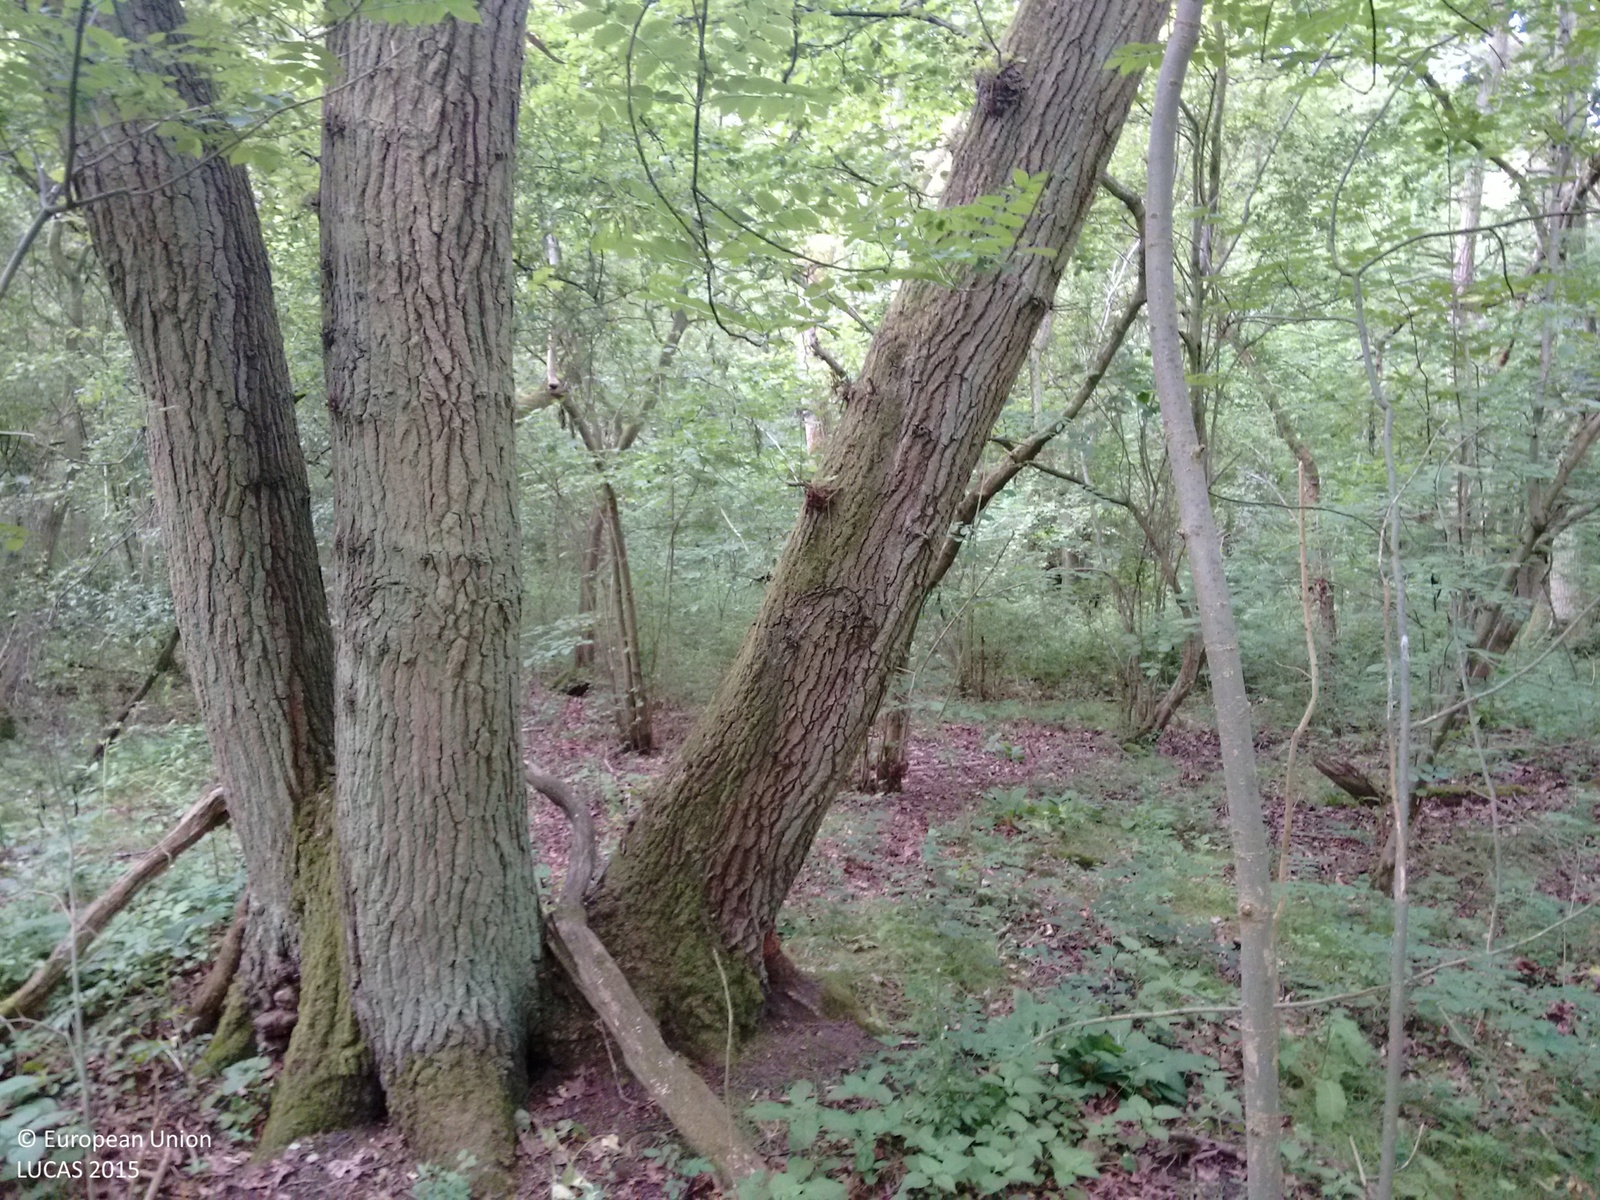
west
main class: Woodland
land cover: Broadleaved woodland
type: mesophytic deciduous forest
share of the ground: > 75 %
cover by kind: broadleaved forest trees 90 %, herbaceous plants 10 %
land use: Semi-natural and natural areas not in use
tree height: > 5 m
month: June
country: GB
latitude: 52.1291
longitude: -0.6897
